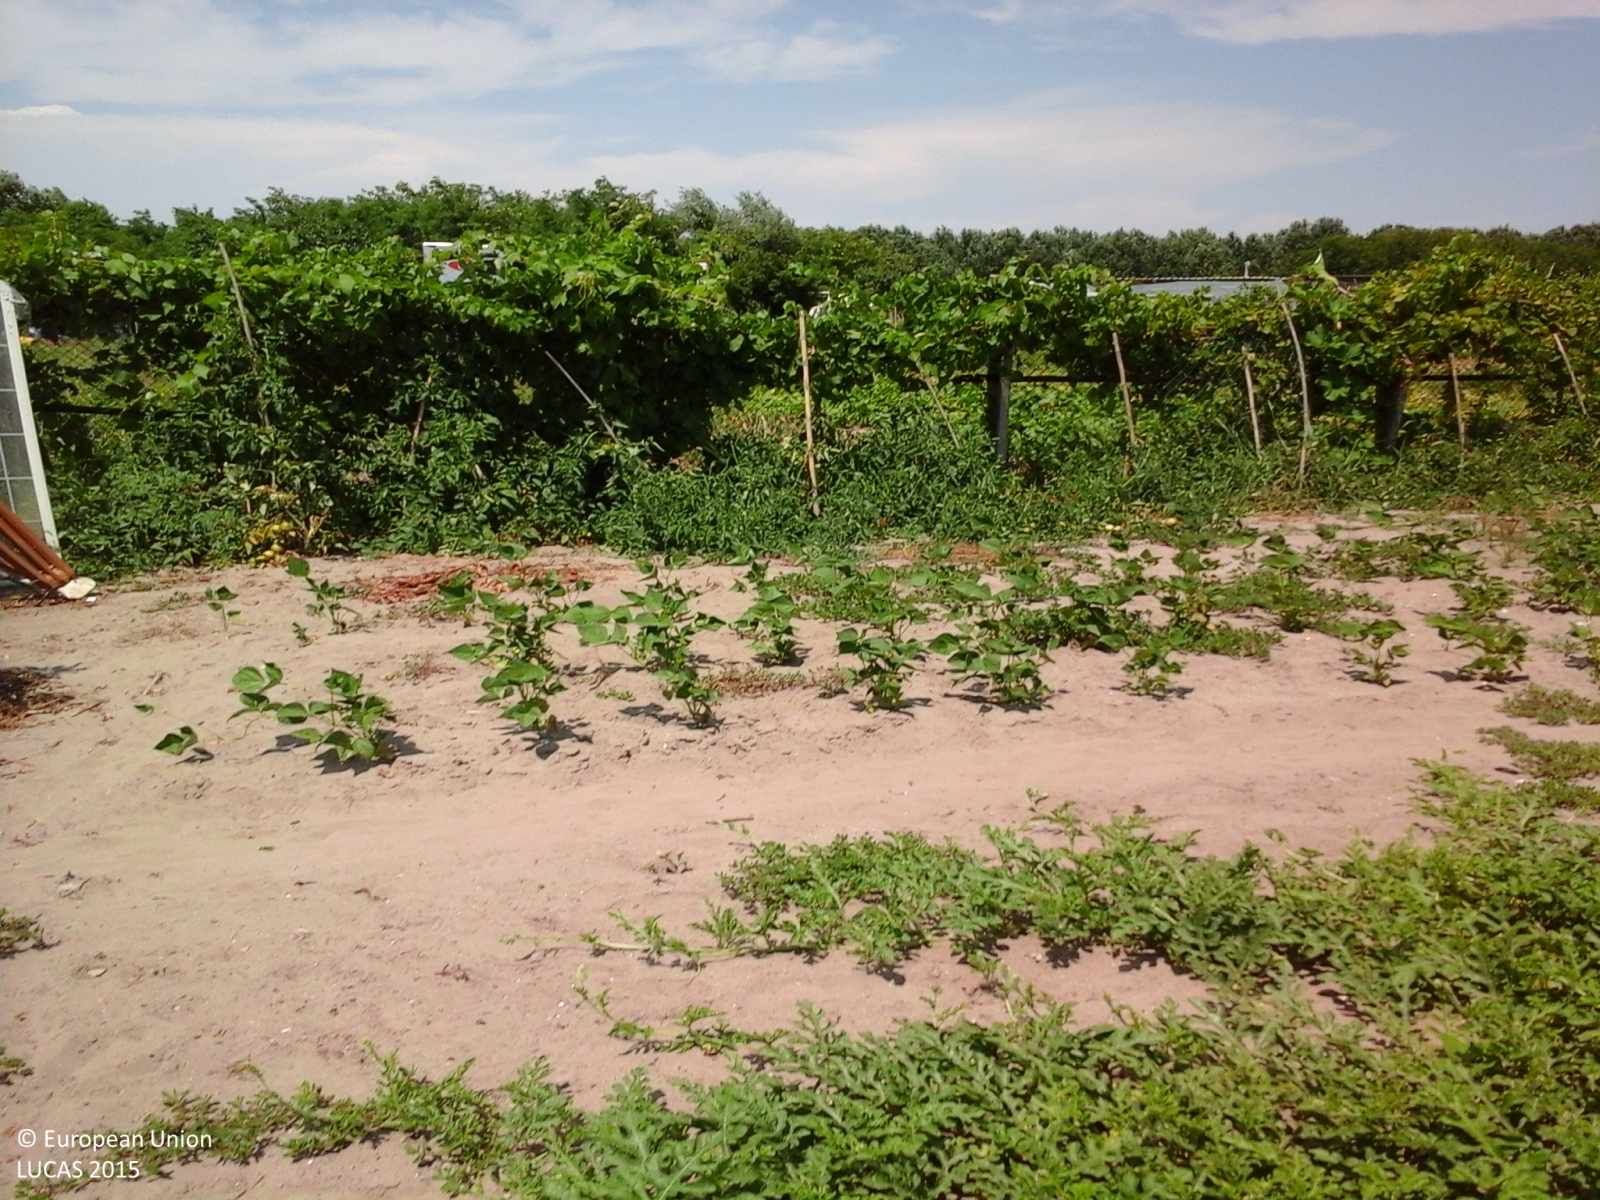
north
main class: Cropland
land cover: Other fresh vegetables
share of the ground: 10 - 25 %
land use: Agriculture (excluding fallow land and kitchen gardens)
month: July
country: IT
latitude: 45.1909
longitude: 12.2999
